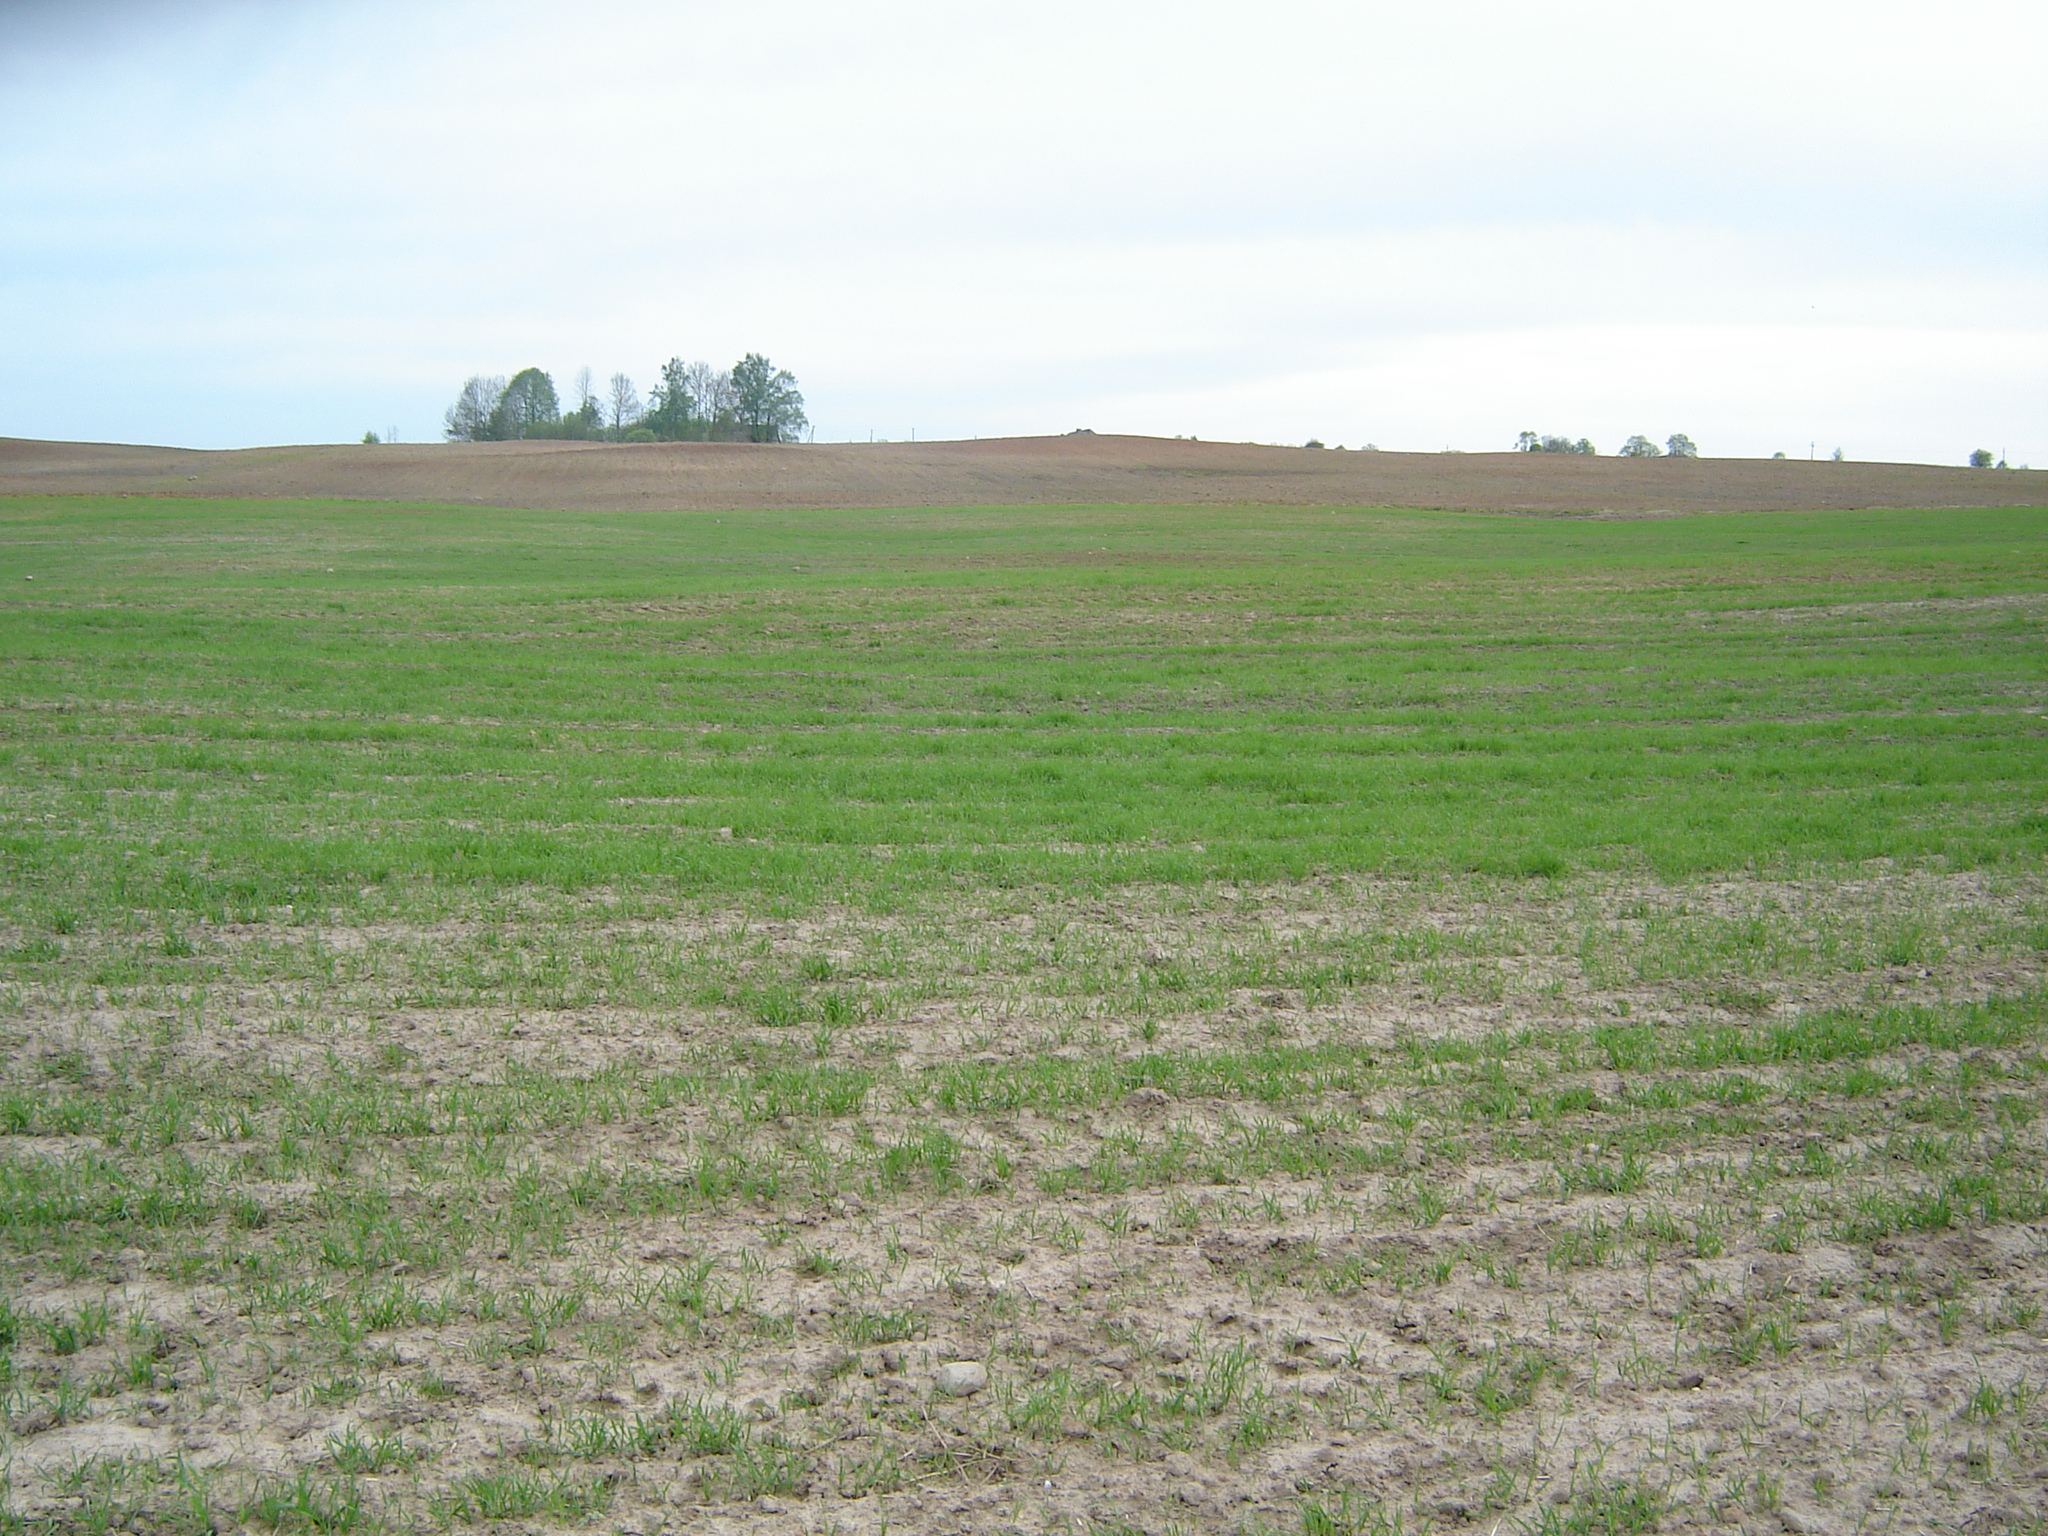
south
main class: Cropland
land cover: Common wheat
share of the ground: 25 - 50 %
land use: Agriculture (excluding fallow land and kitchen gardens)
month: May
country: LT
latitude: 55.8622
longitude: 25.6412
